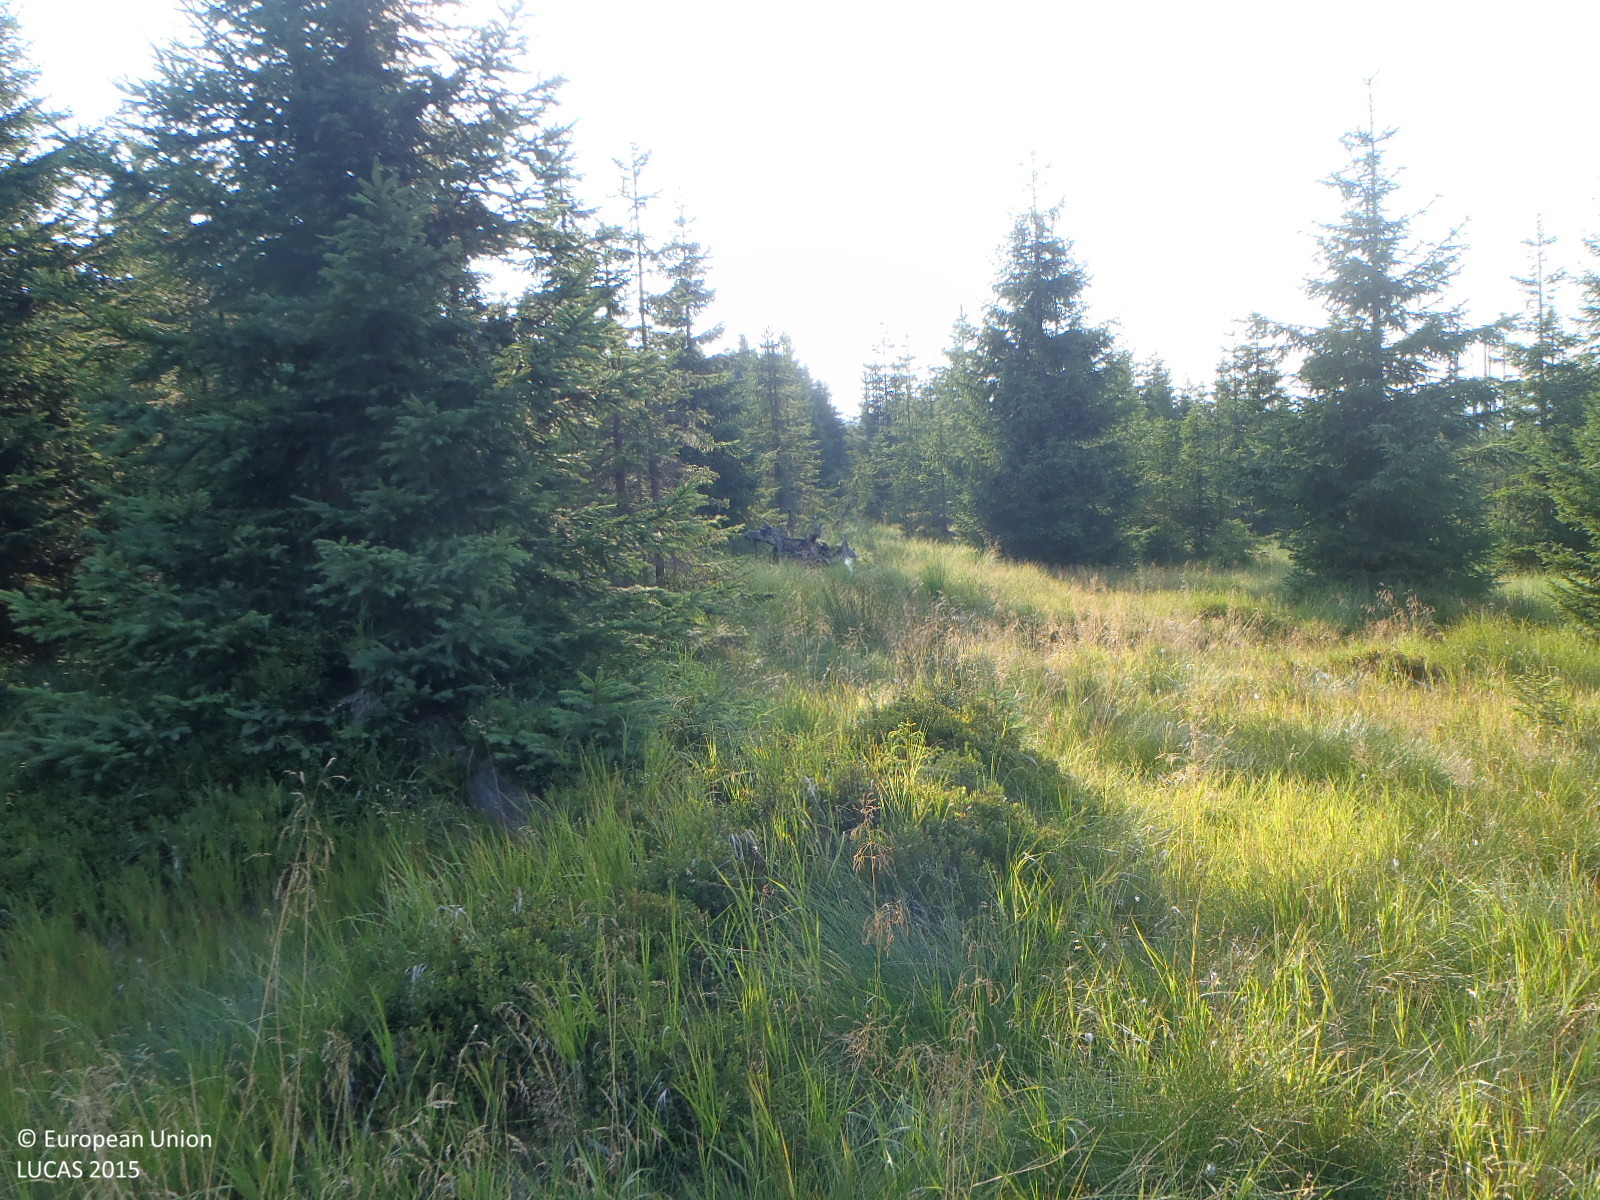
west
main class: Woodland
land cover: Spruce dominated coniferous woodland
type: mire and swamp forests
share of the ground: 25 - 50 %
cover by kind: coniferous forest trees 40 %, herbaceous plants 30 %, lichens and mosses 20 %, shrubs 10 %
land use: Semi-natural and natural areas not in use
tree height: > 5 m
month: August
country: CZ
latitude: 50.8525
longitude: 15.3305
